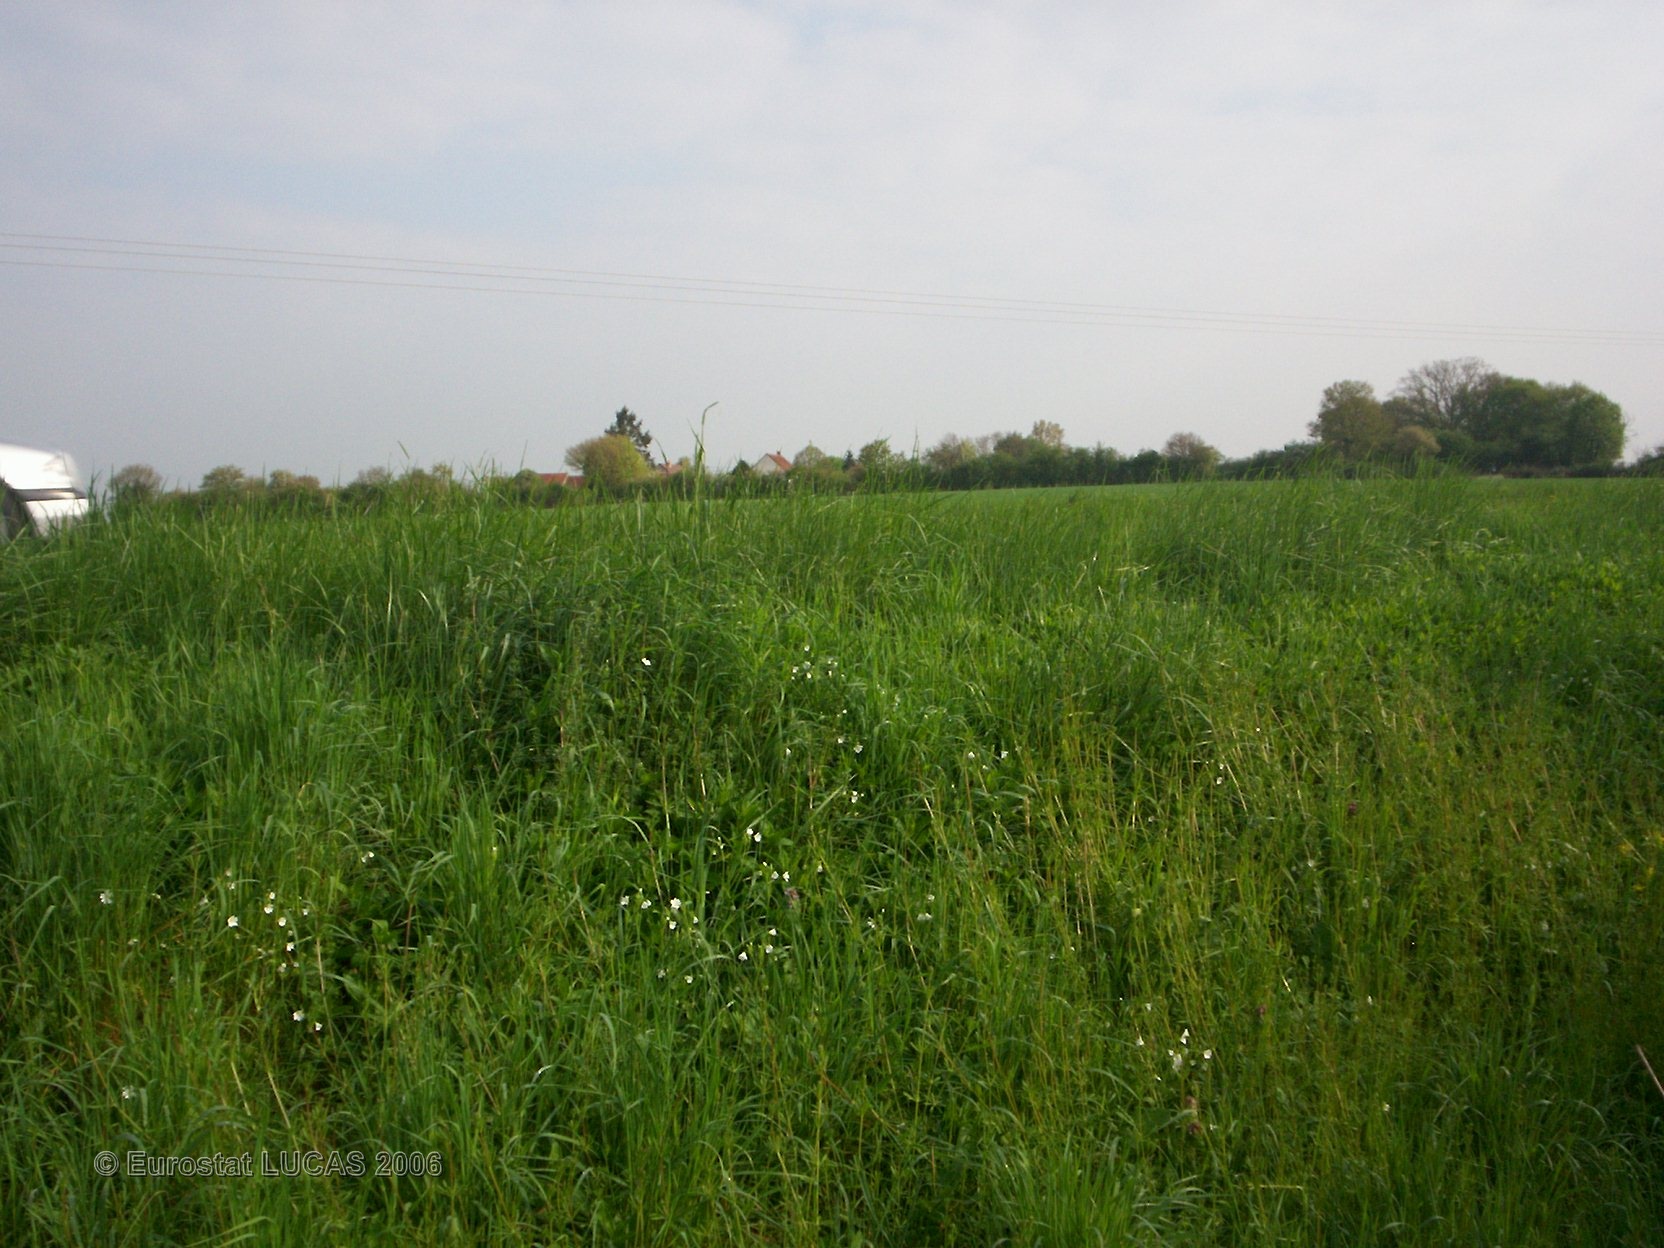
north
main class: Grassland
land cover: Grassland without tree/shrub cover
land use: Agriculture (excluding fallow land and kitchen gardens)
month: April
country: FR
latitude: 47.2119
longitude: 3.0901
